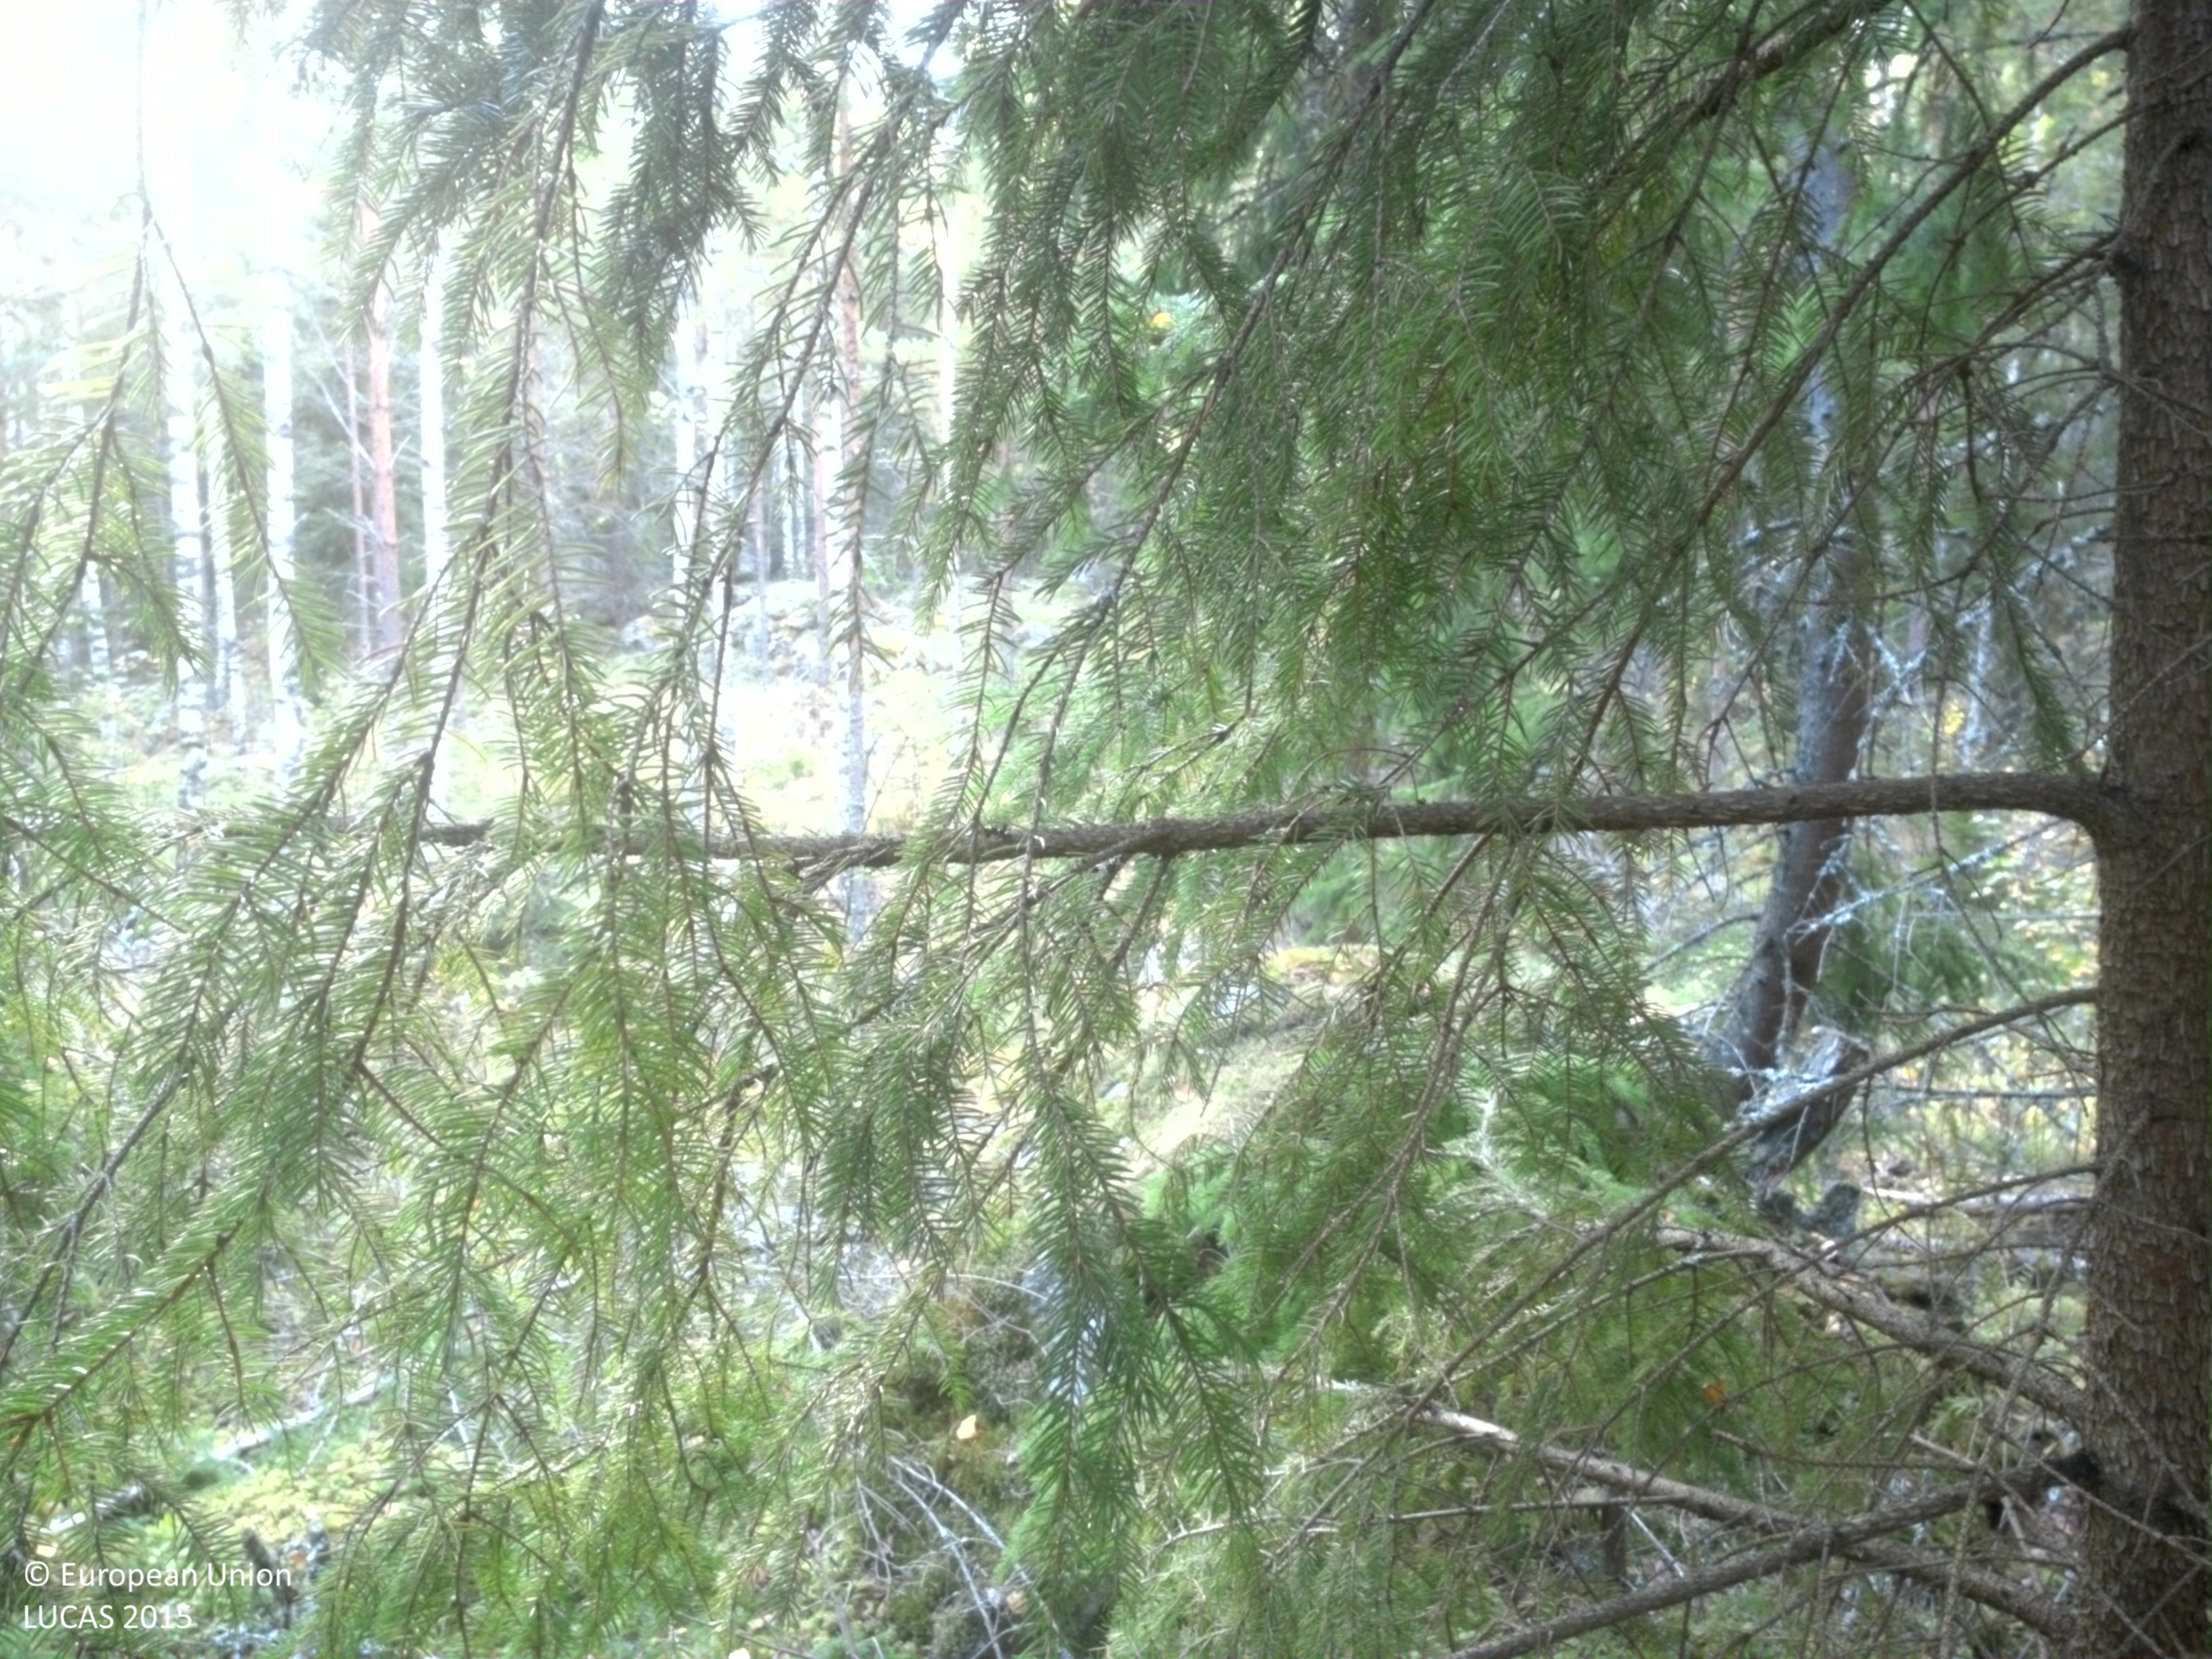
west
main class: Woodland
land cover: Spruce dominated mixed woodland
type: boreal forest
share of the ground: 50 - 75 %
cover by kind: coniferous forest trees 40 %, broadleaved forest trees 25 %, shrubs 20 %, lichens and mosses 10 %, consolidated bare surface 5 %
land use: Forestry
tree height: > 5 m
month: September
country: SE
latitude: 59.5338
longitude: 15.4547
